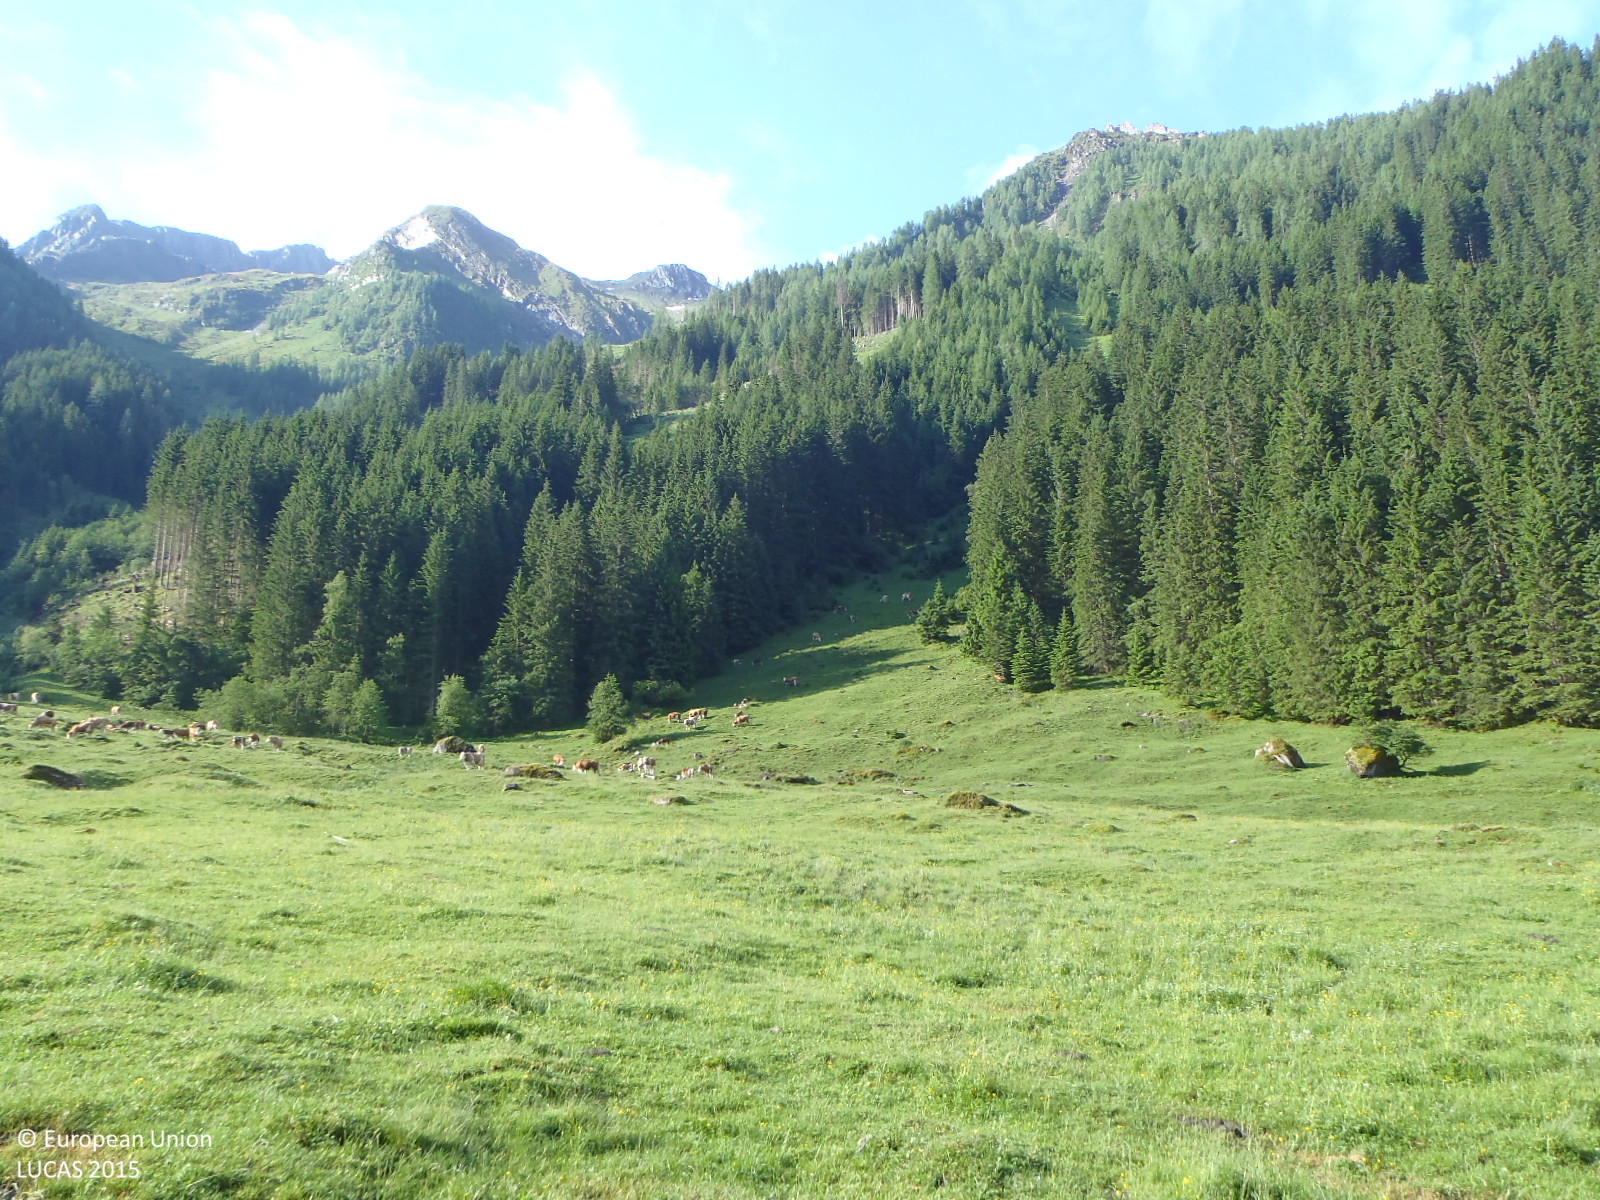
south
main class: Grassland
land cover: Grassland without tree/shrub cover
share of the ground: > 75 %
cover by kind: herbaceous plants 100 %
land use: Agriculture (excluding fallow land and kitchen gardens)
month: June
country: AT
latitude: 47.1959
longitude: 12.8622
